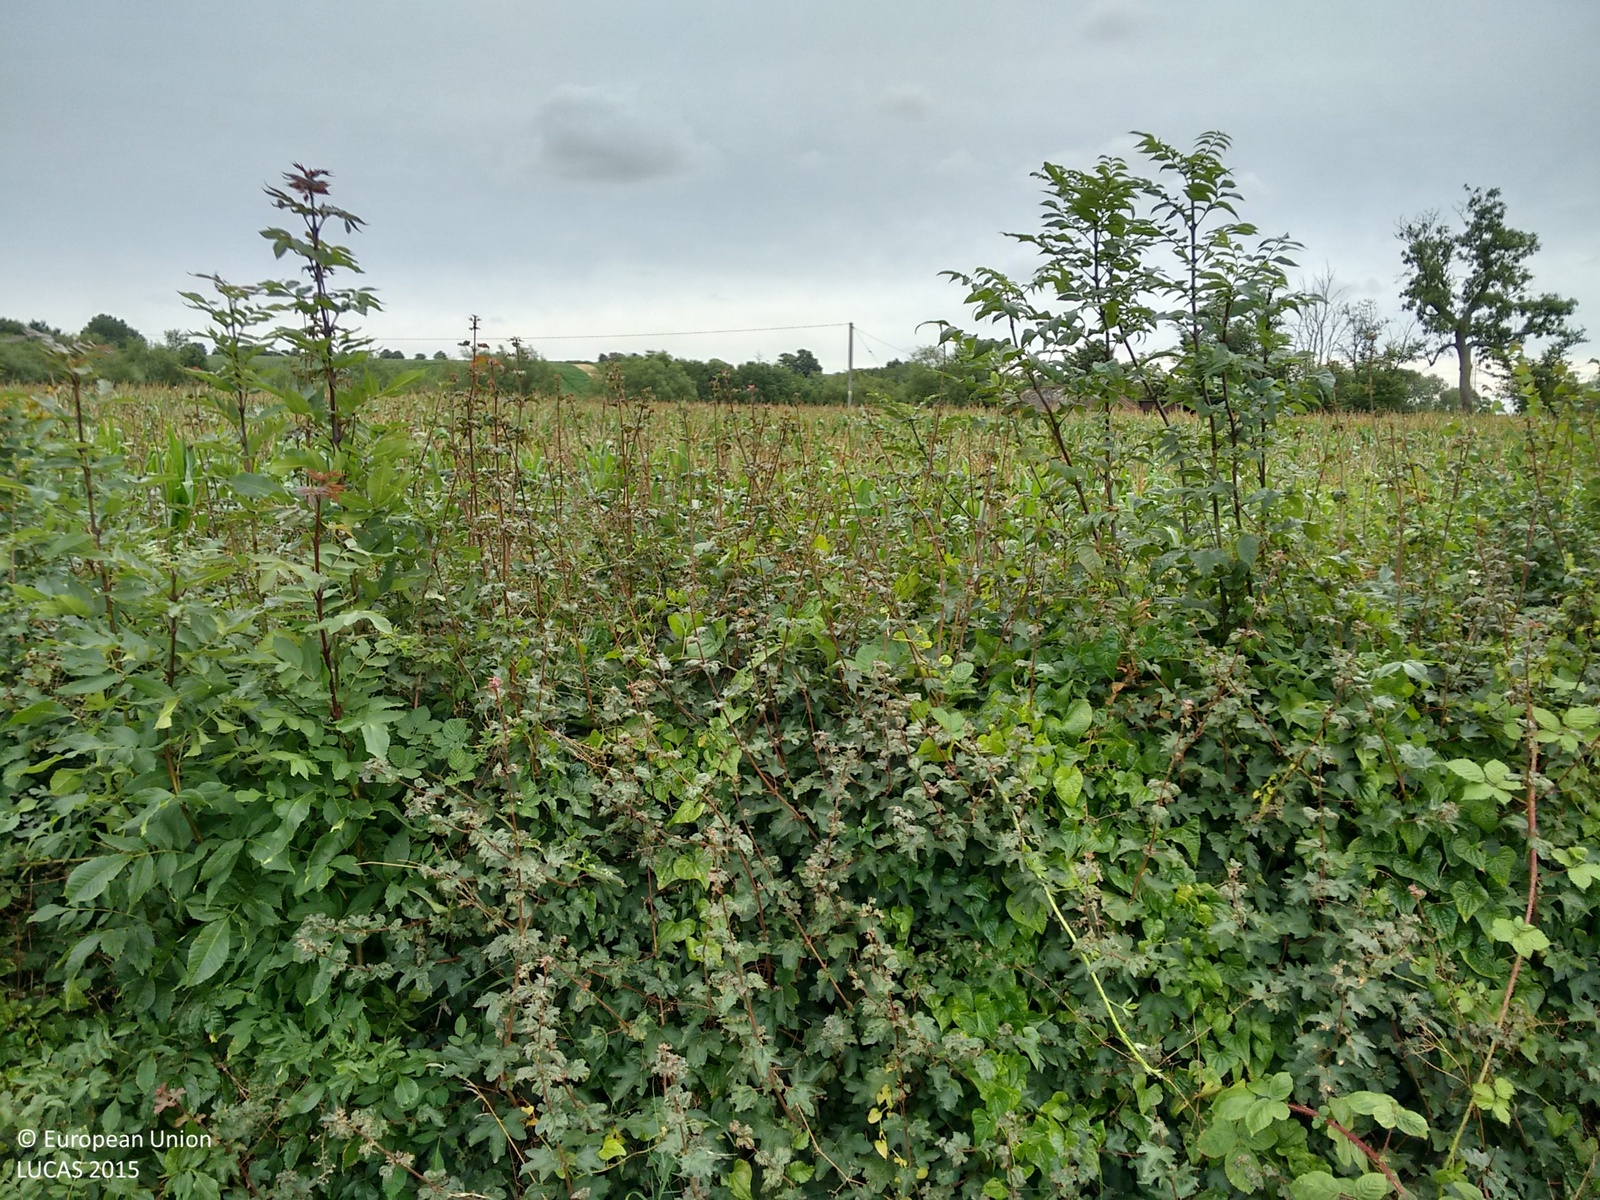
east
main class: Cropland
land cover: Maize
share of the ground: > 75 %
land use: Agriculture (excluding fallow land and kitchen gardens)
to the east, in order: Maize; Electric lines; Maize; Broadleaved woodland; Rivers and streams; Broadleaved woodland; Grassland without tree/shrub cover; Maize
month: August
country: GB
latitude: 52.0806
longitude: -1.2101
